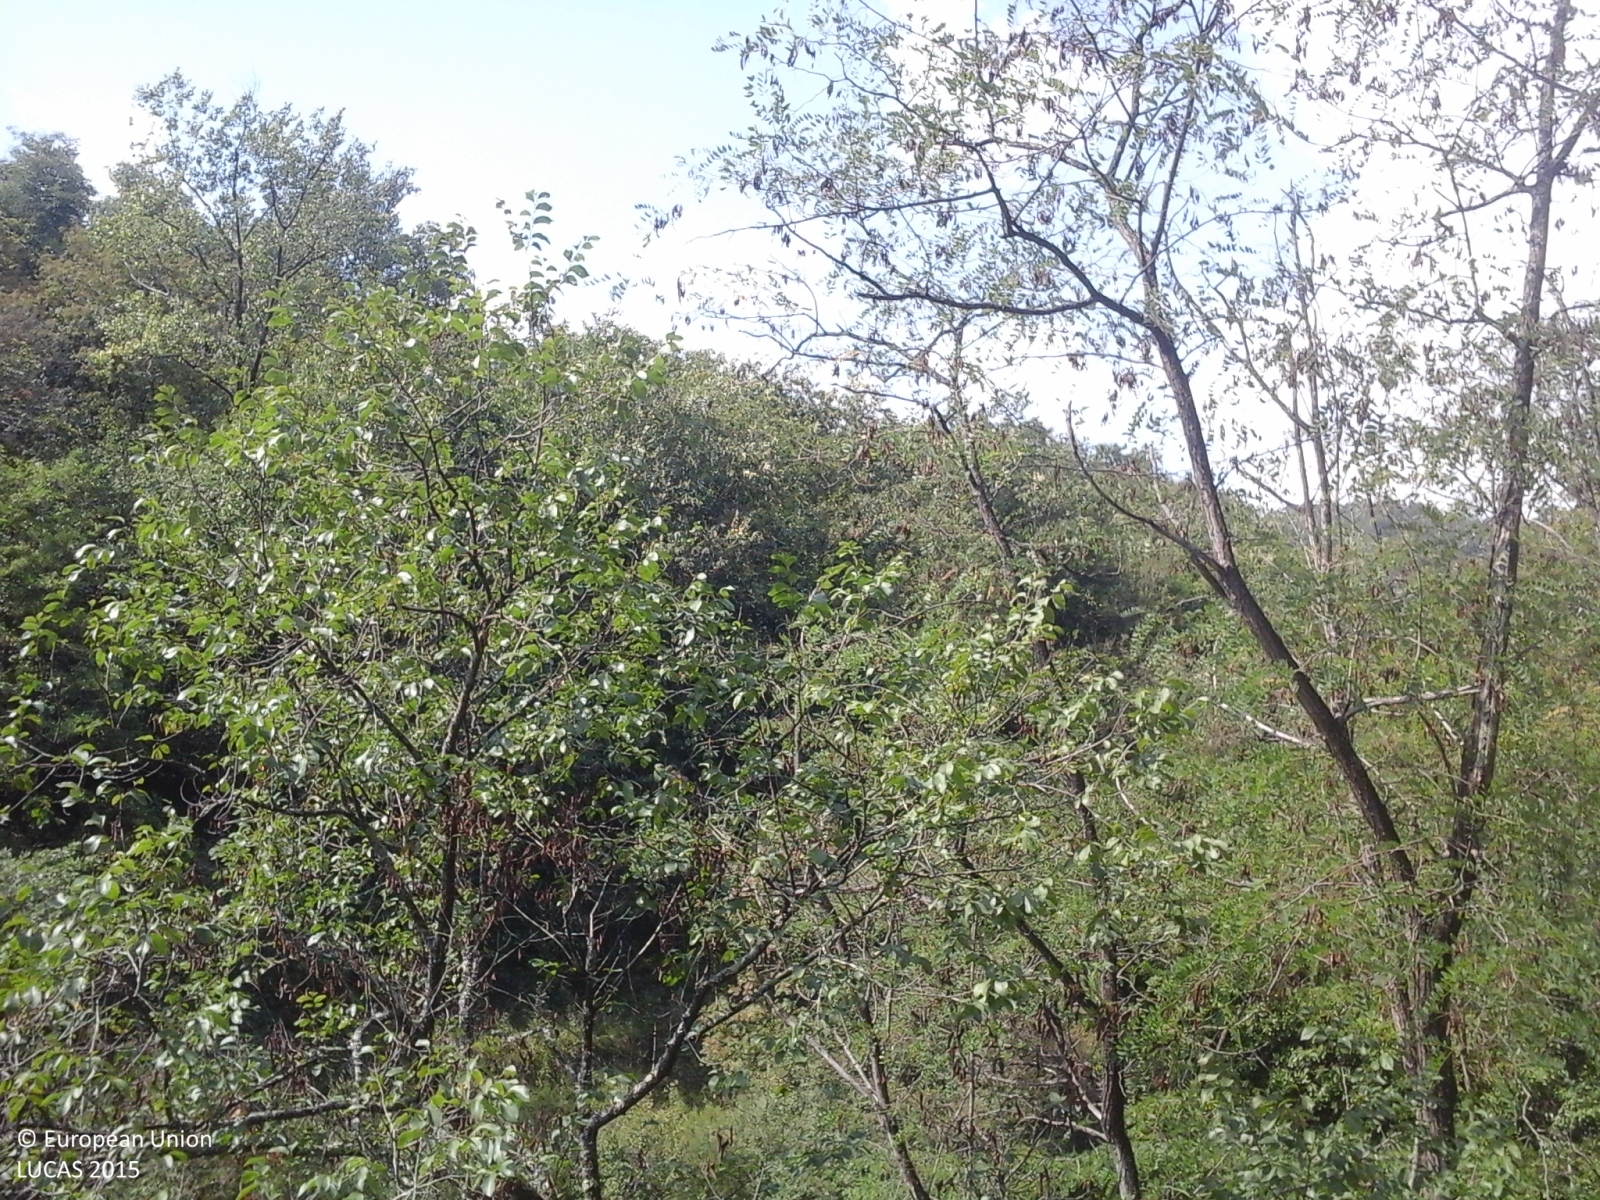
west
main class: Woodland
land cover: Broadleaved woodland
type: thermophilous deciduous forest
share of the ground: > 75 %
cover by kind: broadleaved forest trees 100 %
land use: Semi-natural and natural areas not in use
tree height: > 5 m
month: September
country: IT
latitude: 44.4373
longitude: 9.1601
